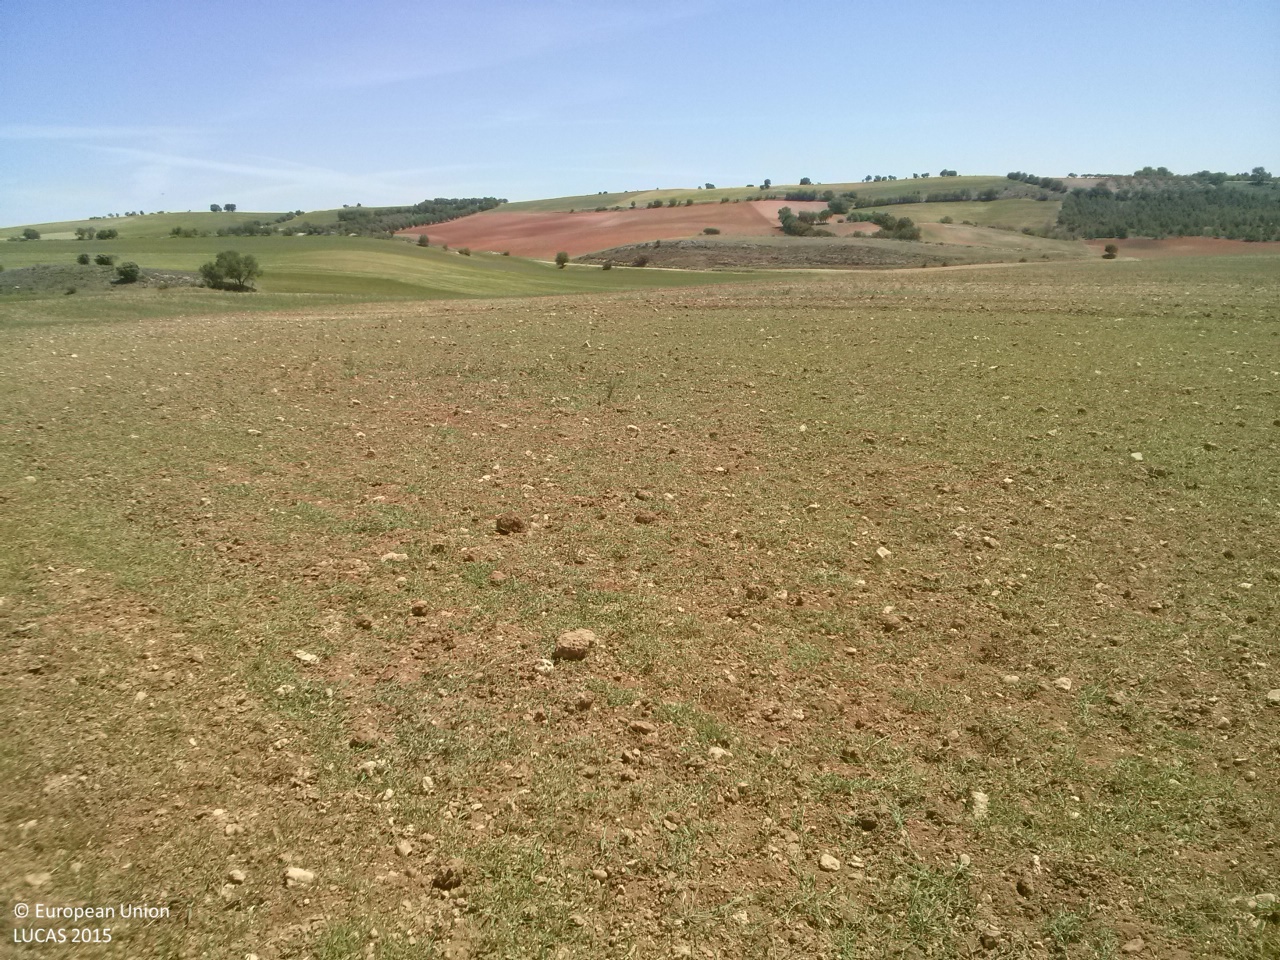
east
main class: Grassland
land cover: Spontaneously vegetated surfaces
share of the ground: 25 - 50 %
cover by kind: unconsolidated bare surface 60 %, herbaceous plants 40 %
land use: Fallow land
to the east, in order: Spontaneously vegetated surfaces
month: May
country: ES
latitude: 39.9389
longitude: -2.7883
